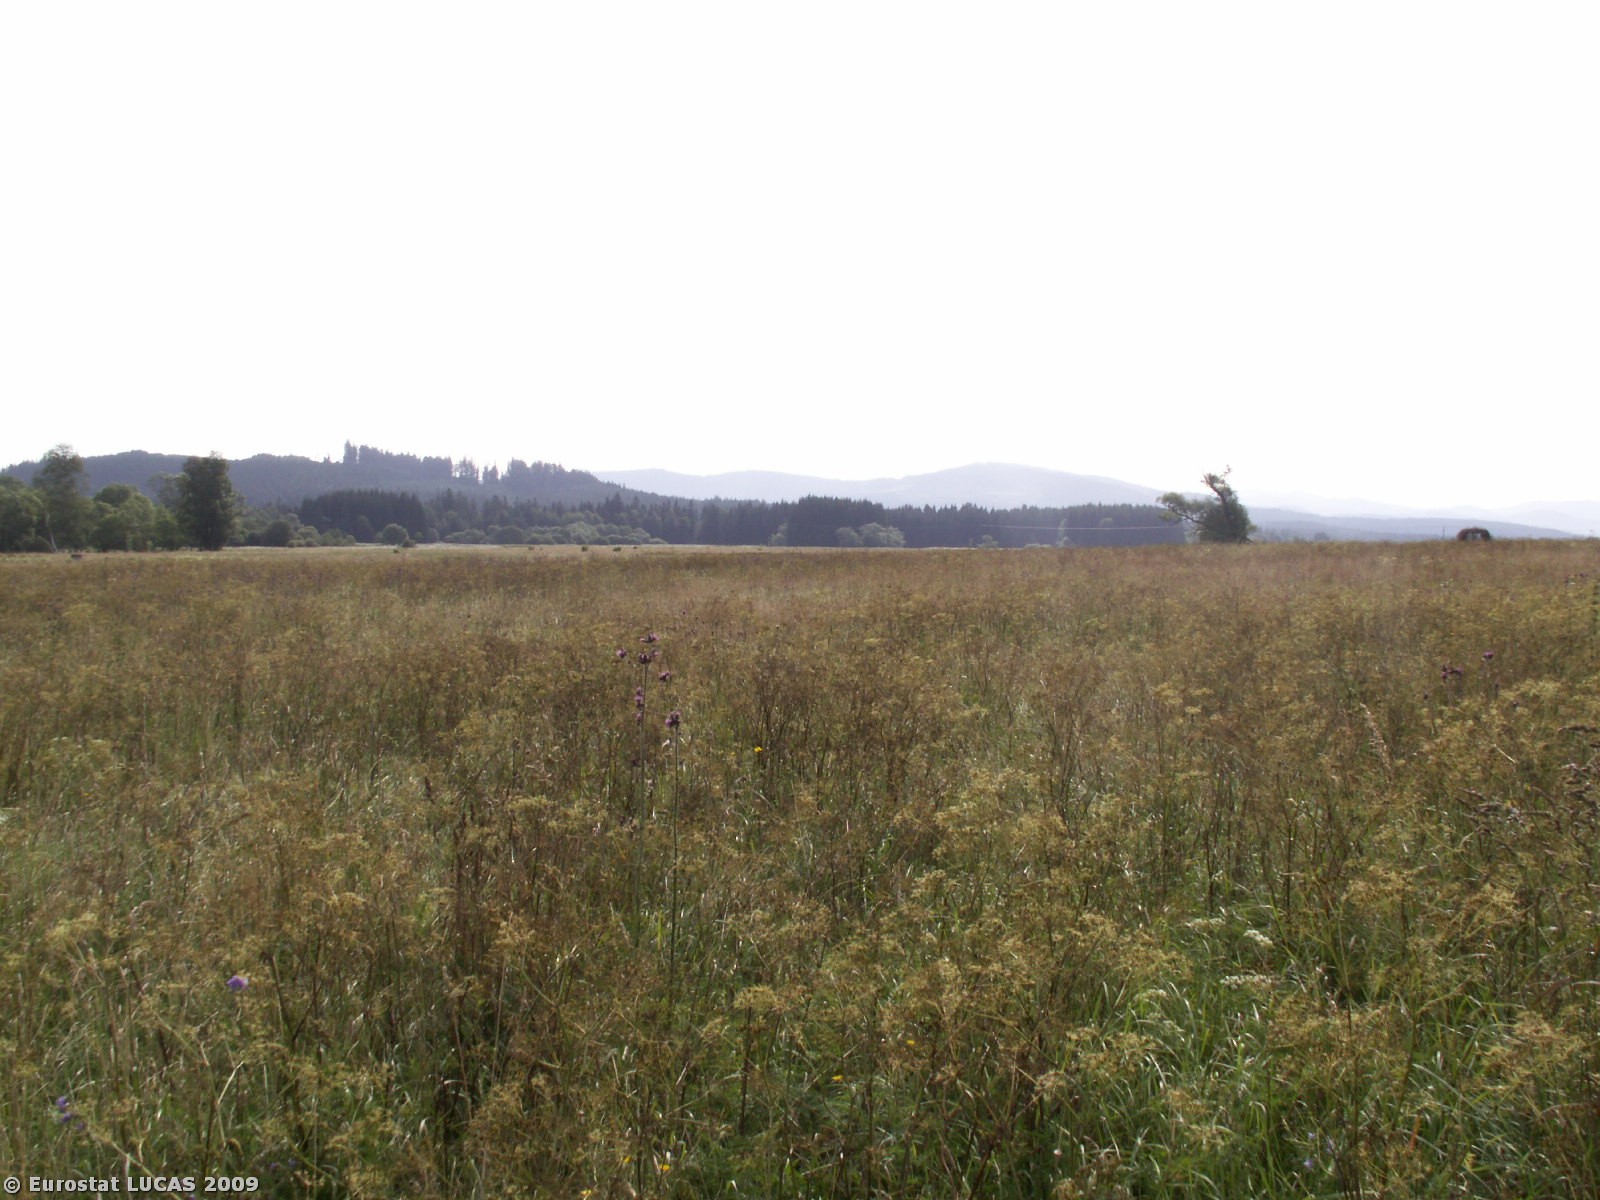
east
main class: Grassland
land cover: Grassland without tree/shrub cover
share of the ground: > 75 %
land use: Fallow land
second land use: Nature reserves
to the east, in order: Grassland without tree/shrub cover
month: July
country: CZ
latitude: 48.8954
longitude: 13.8331
